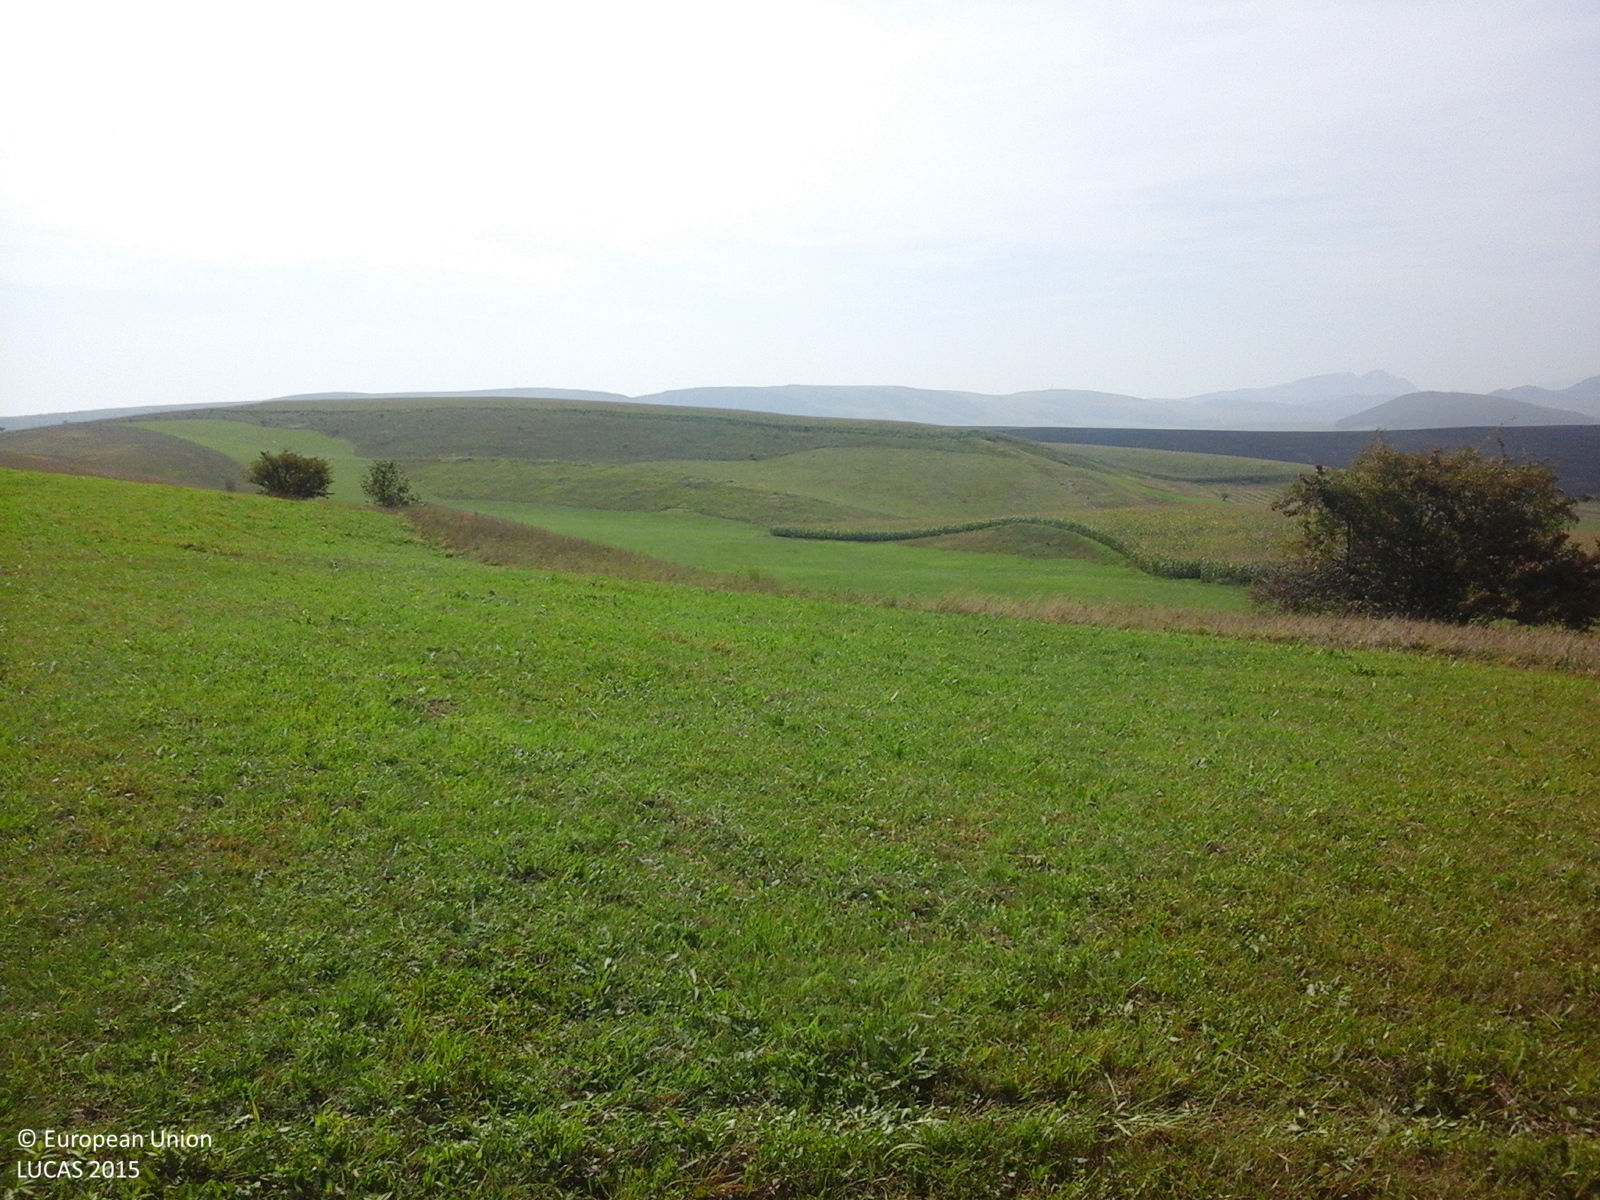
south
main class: Grassland
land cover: Grassland without tree/shrub cover
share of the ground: > 75 %
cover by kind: herbaceous plants 100 %
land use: Agriculture (excluding fallow land and kitchen gardens)
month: September
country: RO
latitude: 46.6193
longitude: 23.6656
